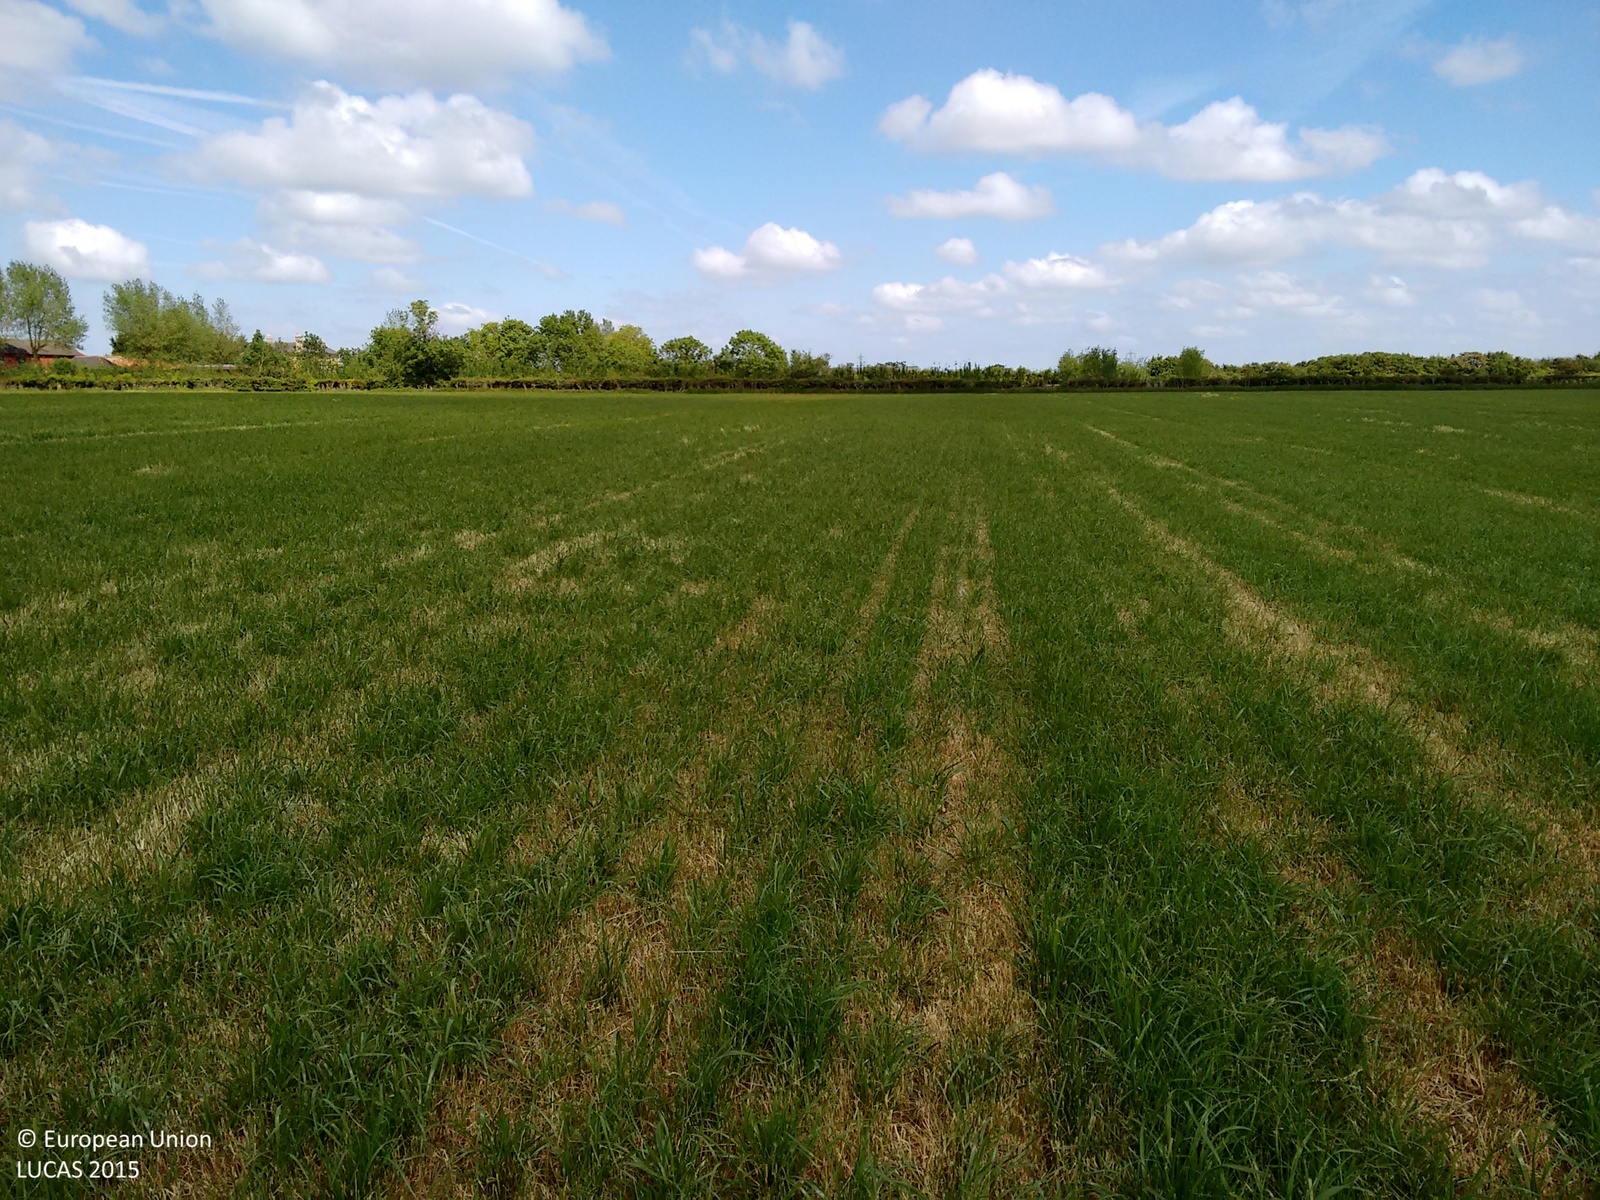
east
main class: Grassland
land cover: Grassland without tree/shrub cover
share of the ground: > 75 %
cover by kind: herbaceous plants 100 %
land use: Agriculture (excluding fallow land and kitchen gardens)
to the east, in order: Grassland without tree/shrub cover; Managed hedges; Ditches and canals; Grassland without tree/shrub cover; Lines of trees; Fences; Grassland without tree/shrub cover; Fences; Grassland without tree/shrub cover; Artificial constructions in urban areas
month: June
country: GB
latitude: 52.7766
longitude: -0.5488
